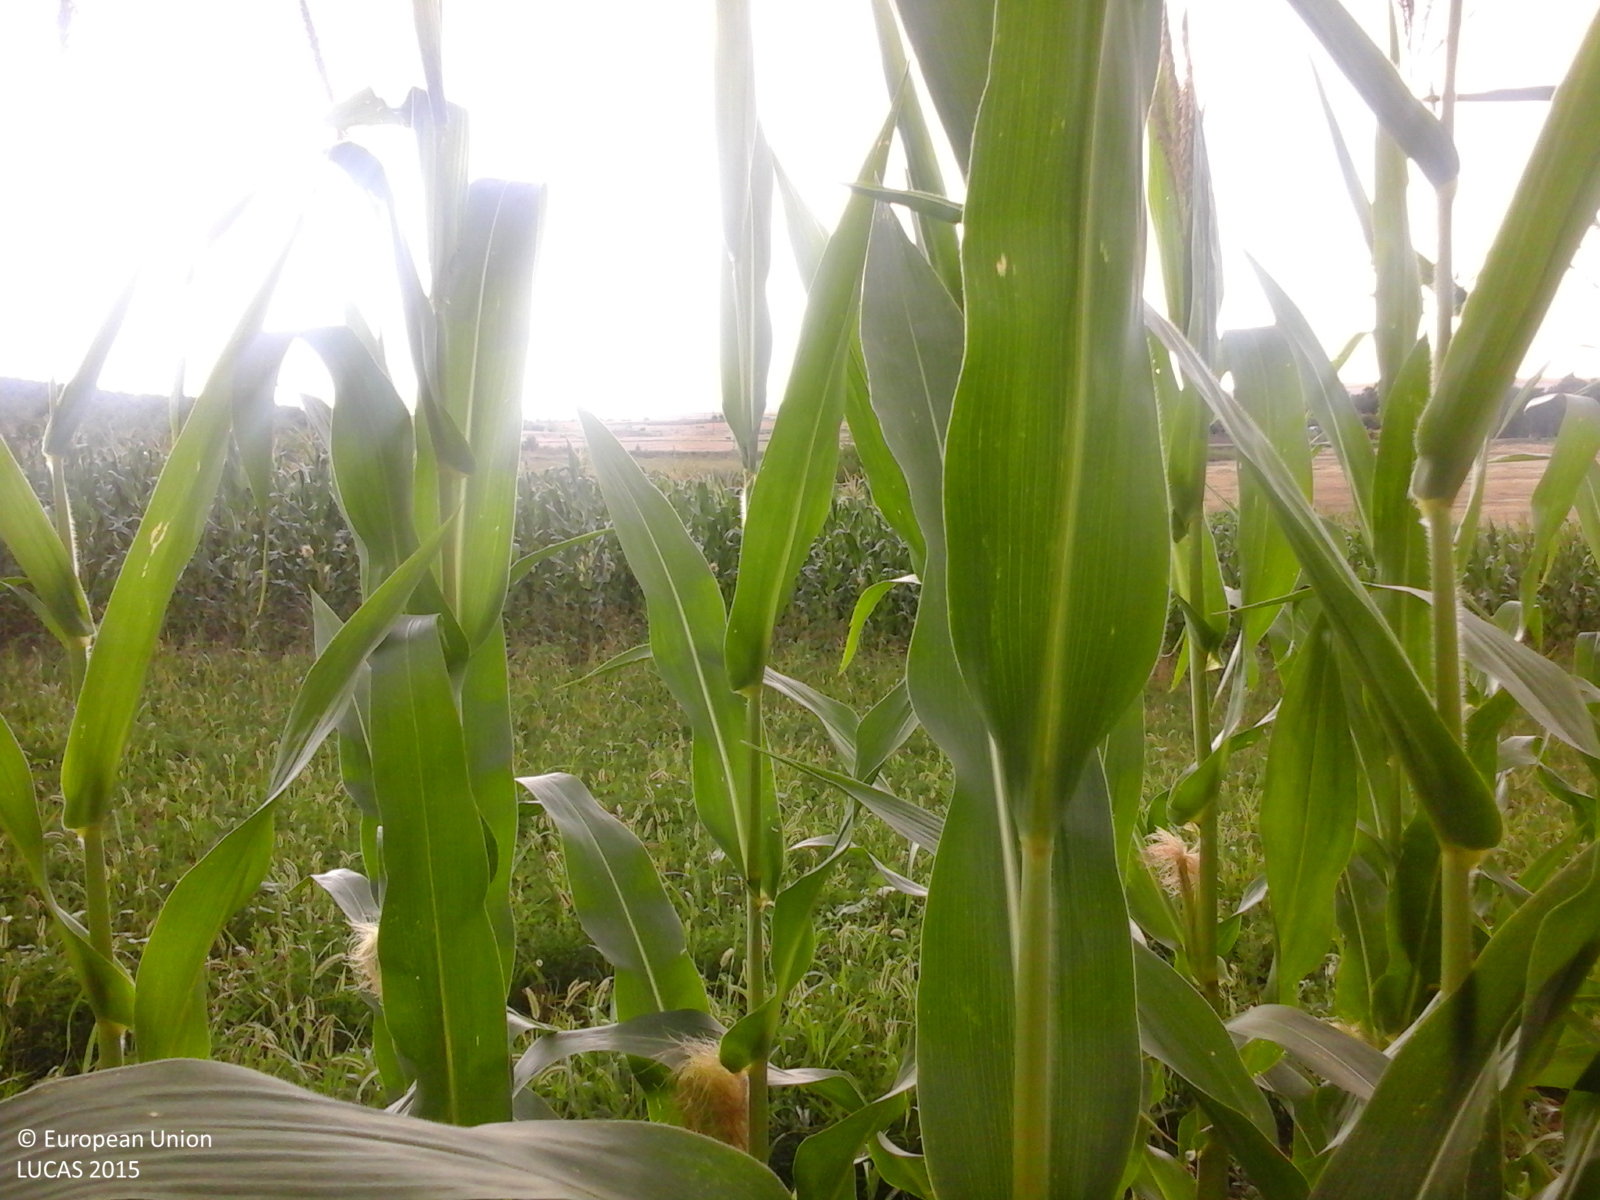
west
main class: Cropland
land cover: Maize
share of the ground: > 75 %
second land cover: Dry pulses
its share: < 10 %
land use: Agriculture (excluding fallow land and kitchen gardens)
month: July
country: RO
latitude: 43.8546
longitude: 25.1432
